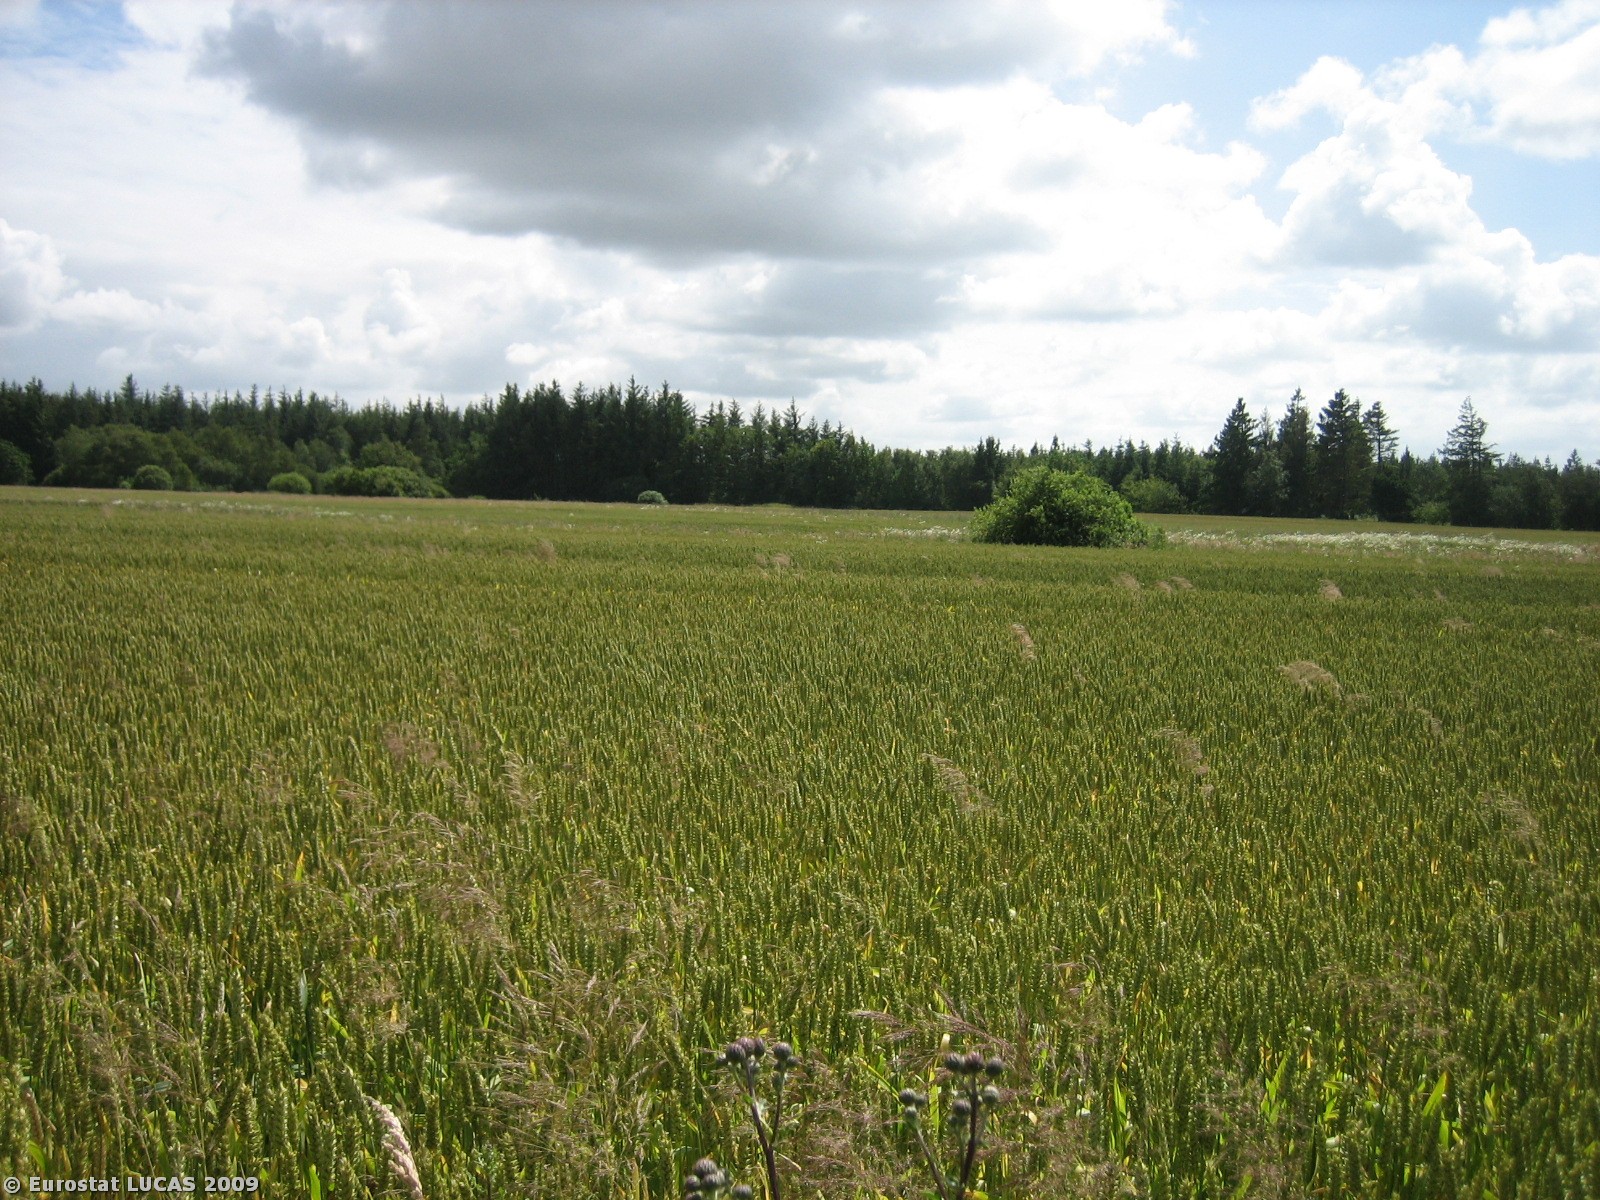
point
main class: Cropland
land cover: Common wheat
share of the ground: > 75 %
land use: Agriculture (excluding fallow land and kitchen gardens)
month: July
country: DK
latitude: 55.9098
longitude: 8.5457
